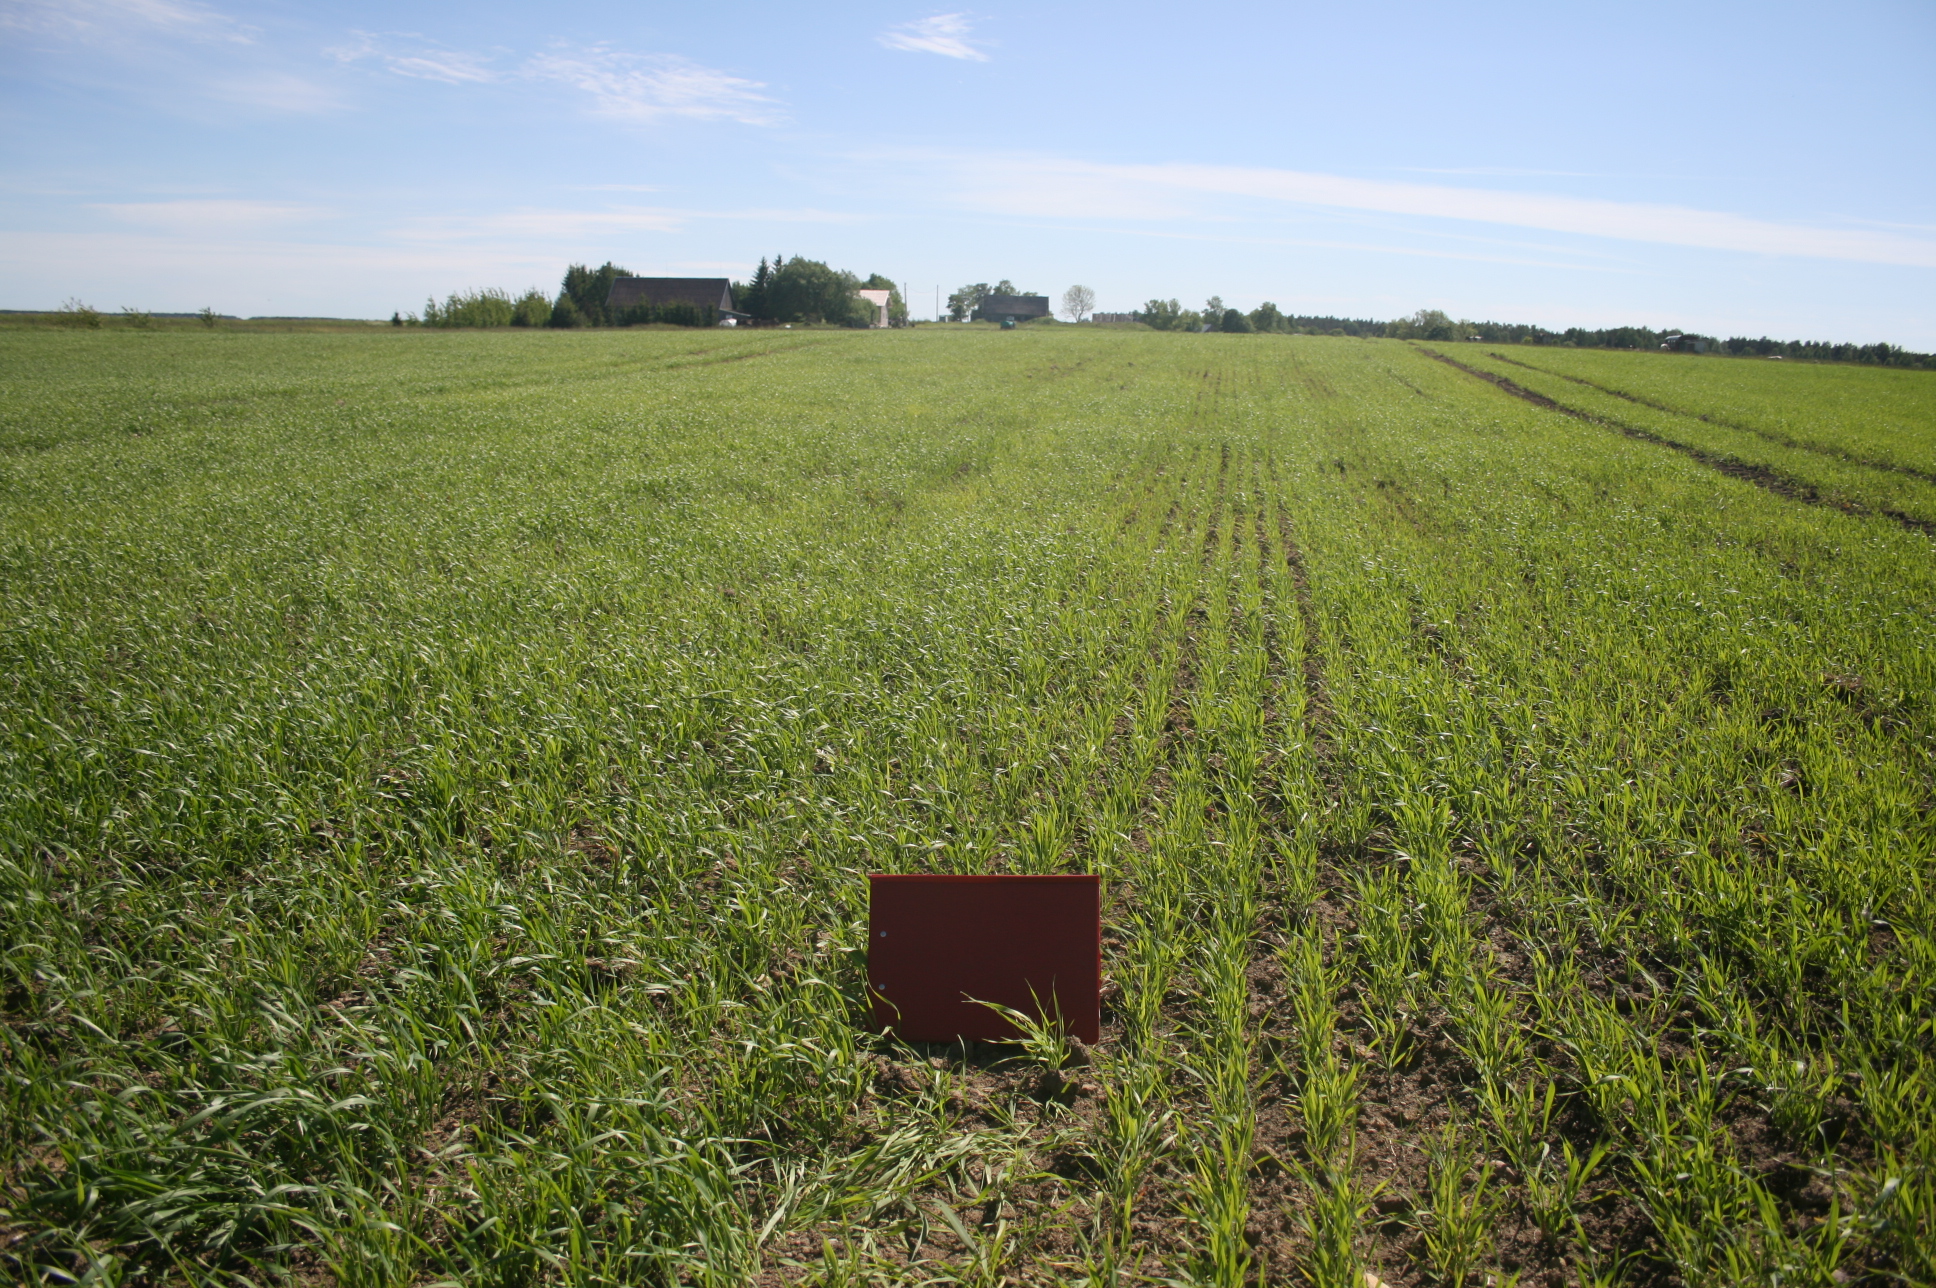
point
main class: Cropland
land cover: Common wheat
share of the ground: > 75 %
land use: Agriculture (excluding fallow land and kitchen gardens)
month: June
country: LT
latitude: 55.9451
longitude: 21.4603
